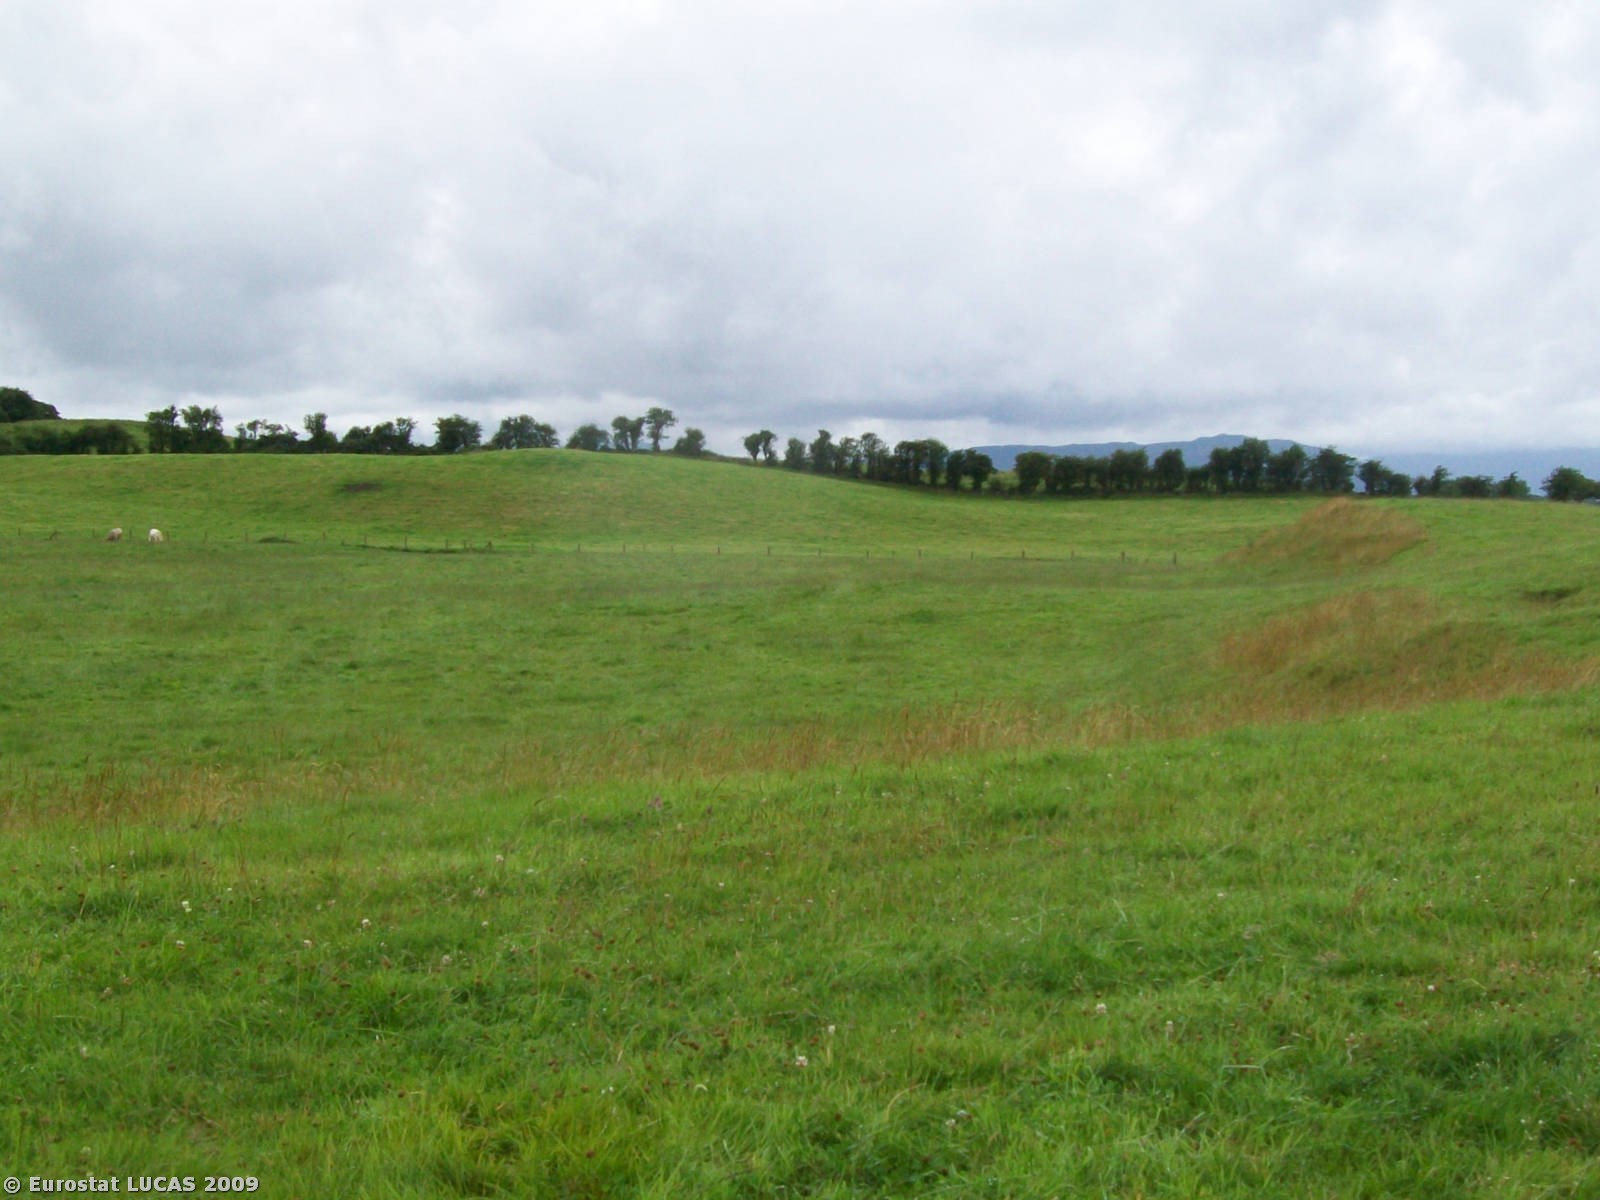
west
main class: Grassland
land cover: Grassland without tree/shrub cover
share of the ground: > 75 %
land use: Agriculture (excluding fallow land and kitchen gardens)
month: July
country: IE
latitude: 53.9361
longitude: -9.0880
